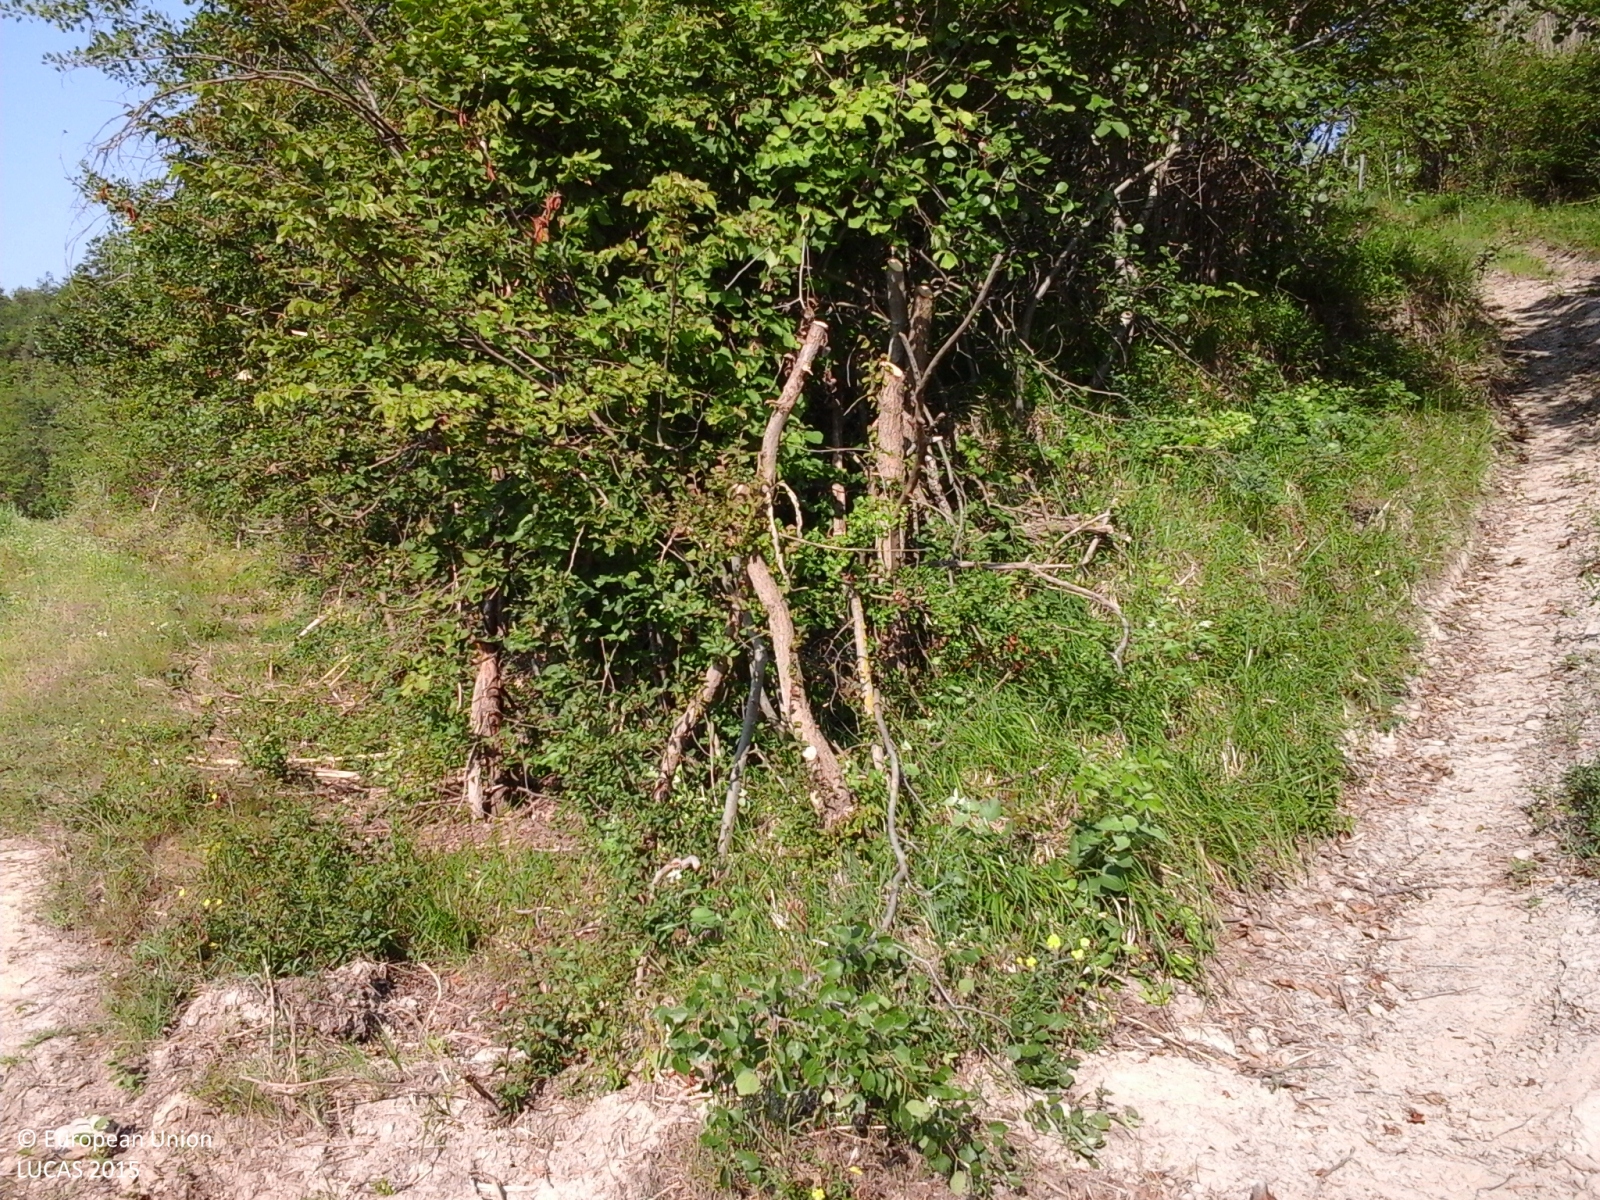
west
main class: Woodland
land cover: Broadleaved woodland
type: mesophytic deciduous forest
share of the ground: > 75 %
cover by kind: broadleaved forest trees 95 %, shrubs 5 %
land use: Forestry
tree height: > 5 m
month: June
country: IT
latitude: 44.6798
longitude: 8.3255
